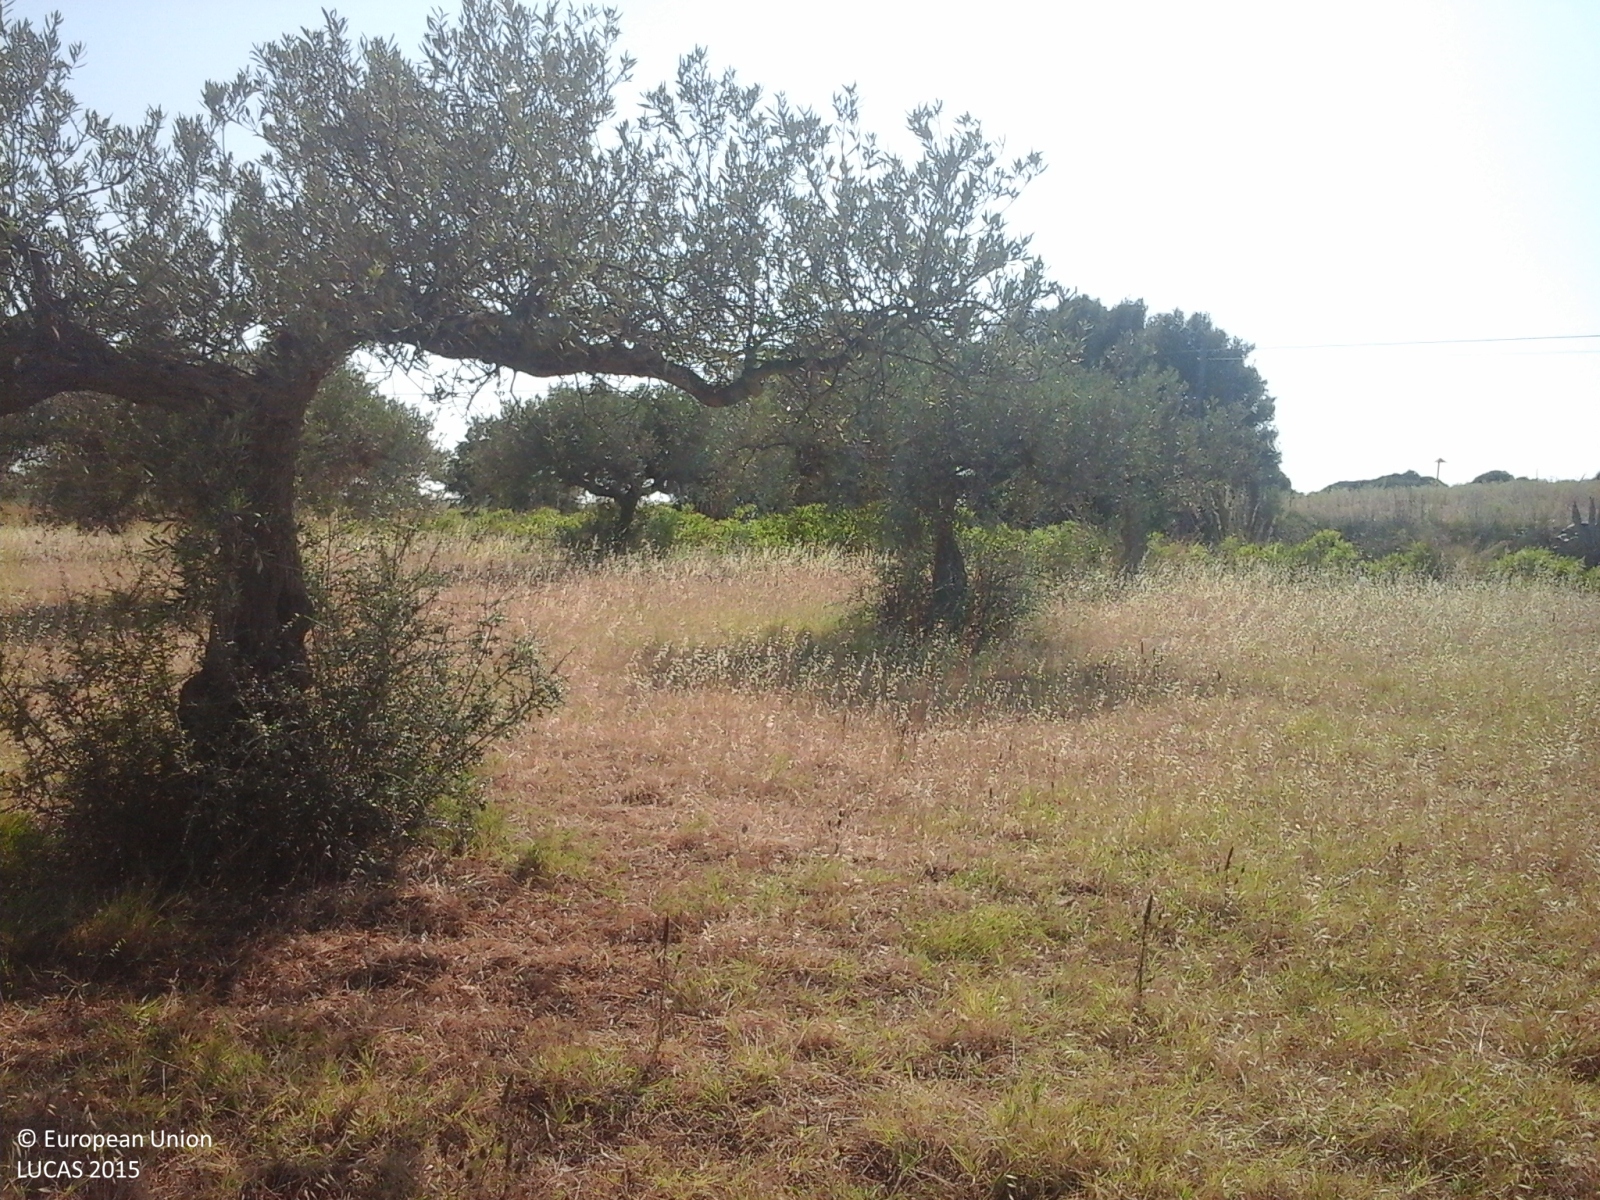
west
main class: Cropland
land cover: Olive groves
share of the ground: 25 - 50 %
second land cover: Spontaneously vegetated surfaces
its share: > 75 %
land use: Agriculture (excluding fallow land and kitchen gardens)
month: May
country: IT
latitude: 37.6282
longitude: 12.9801
